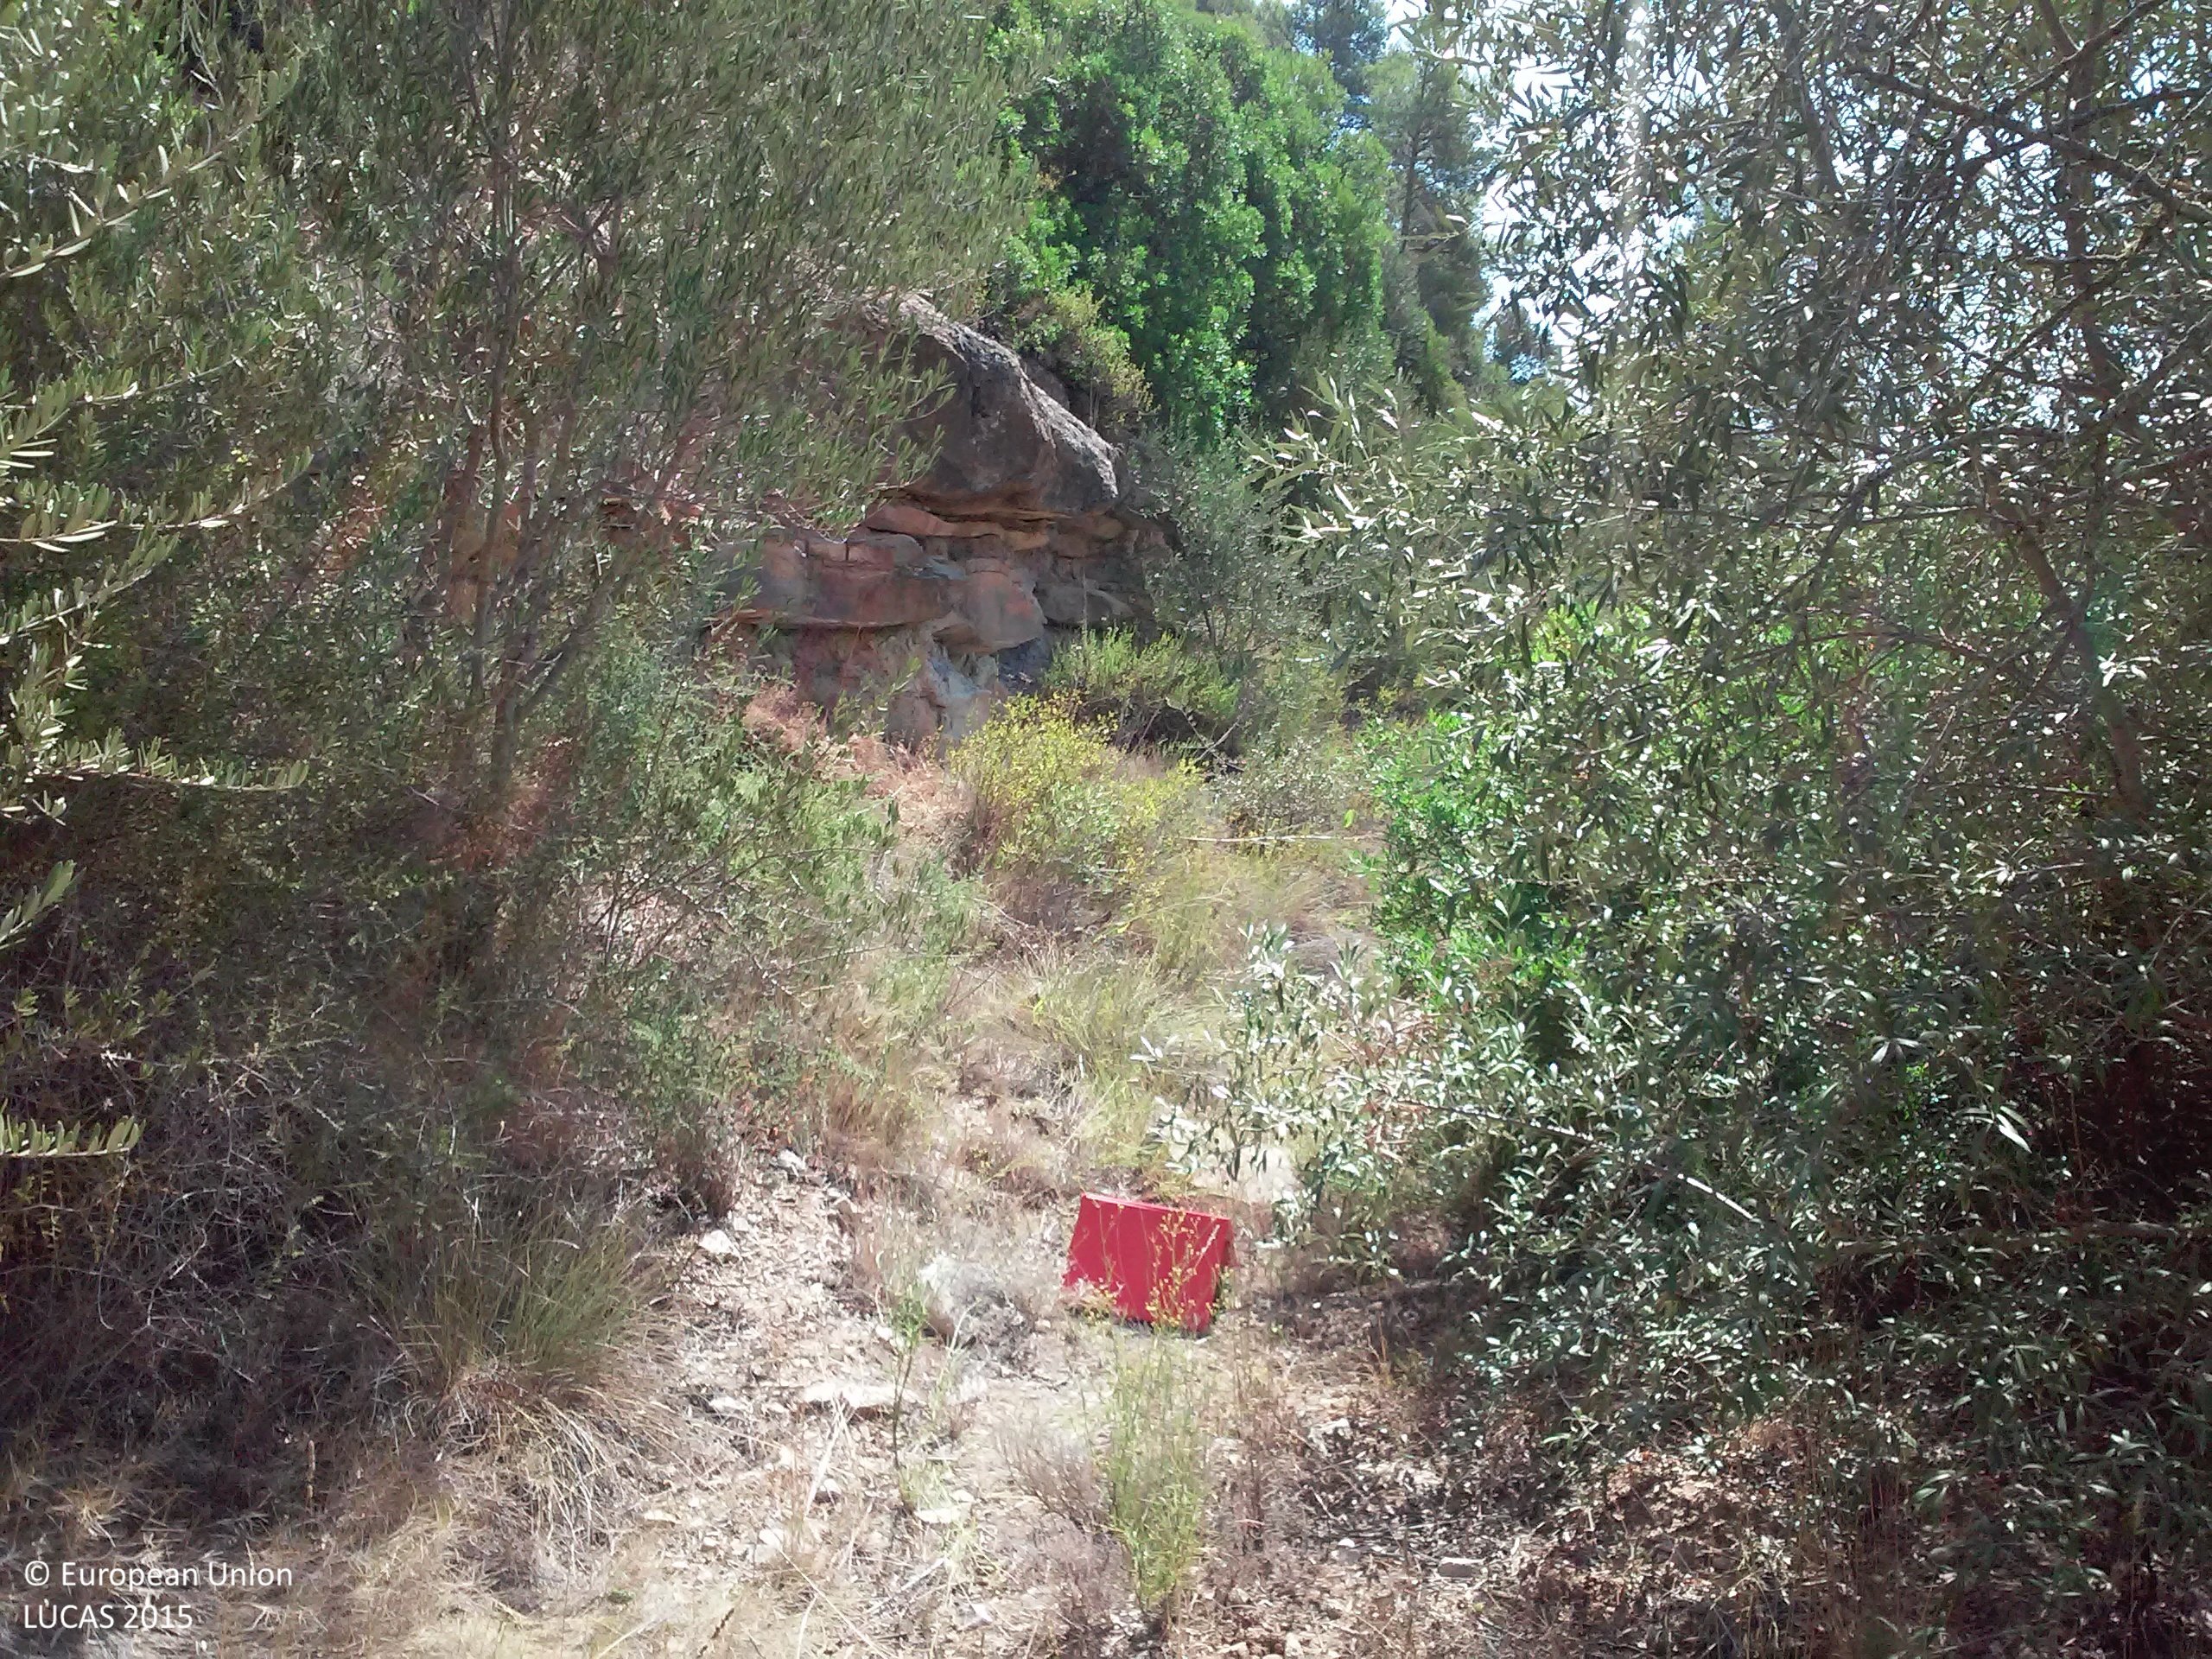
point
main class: Cropland
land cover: Olive groves
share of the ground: < 10 %
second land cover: Shrubland without tree cover
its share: > 75 %
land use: Abandoned areas
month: August
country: ES
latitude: 41.1157
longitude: 0.4994
